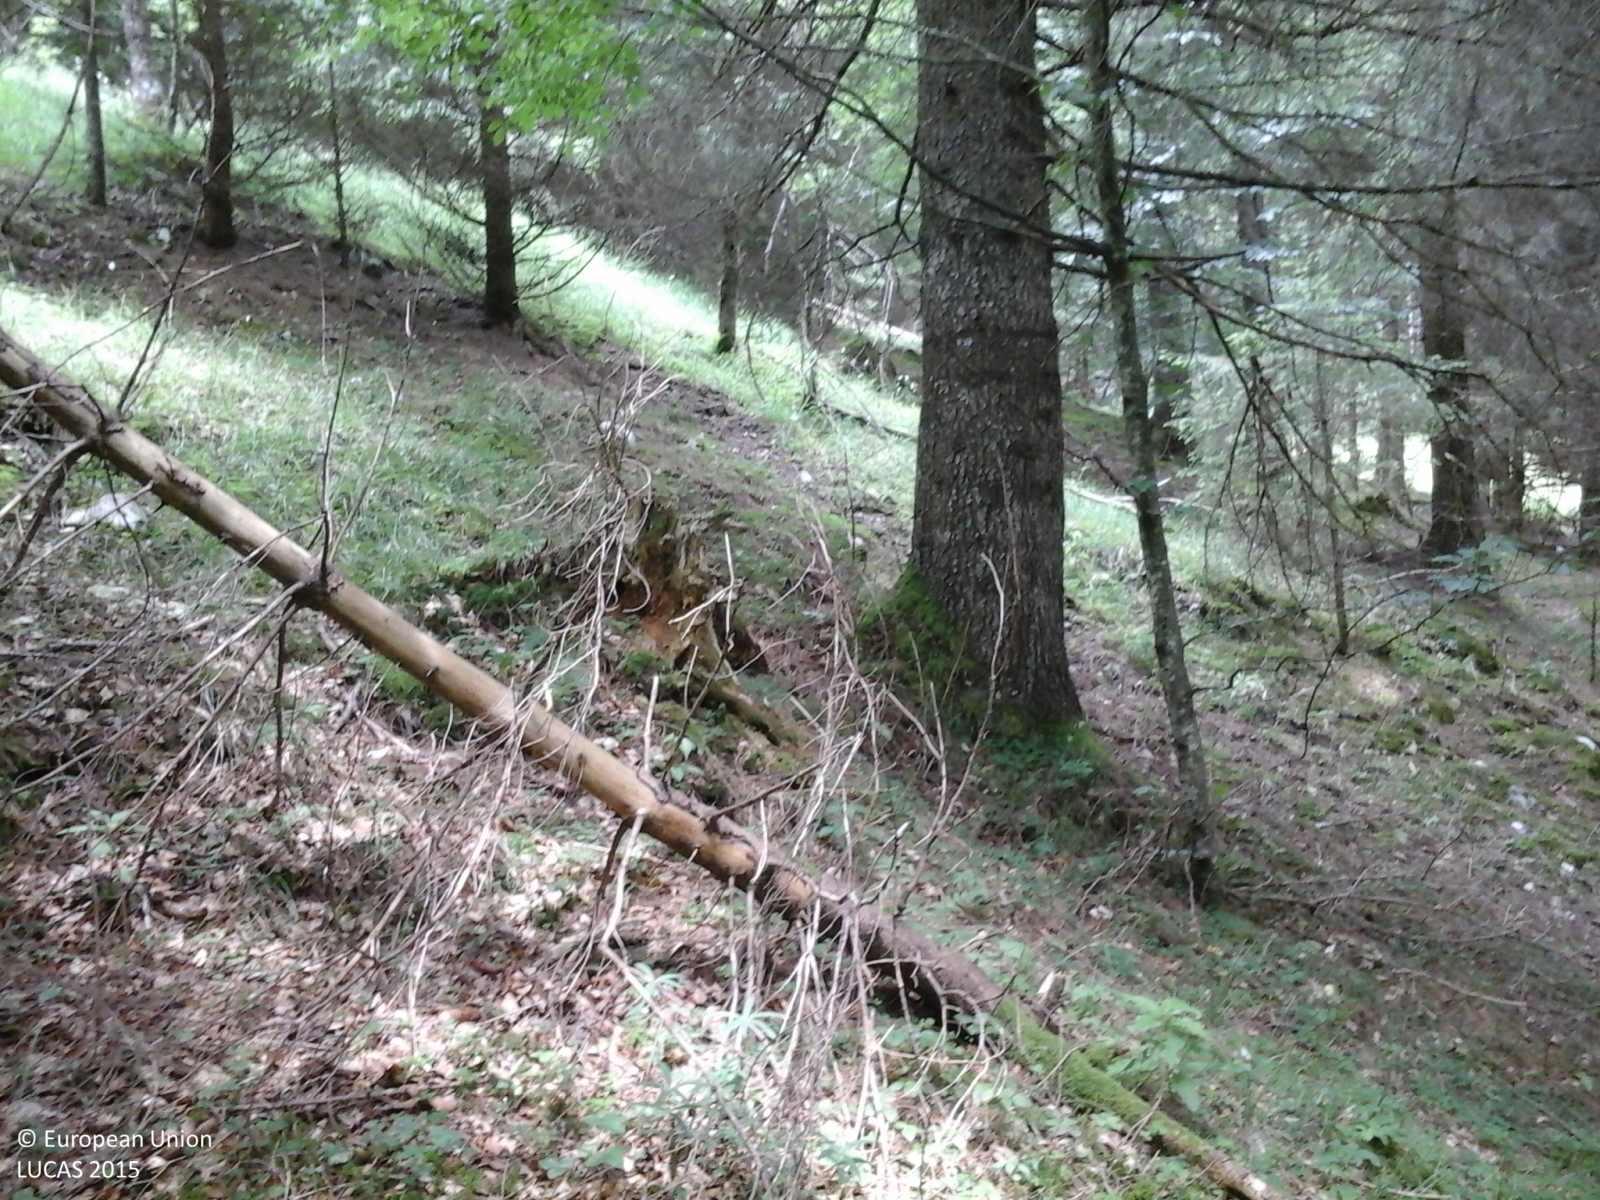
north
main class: Woodland
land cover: Spruce dominated mixed woodland
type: alpine coniferous forest
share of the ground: > 75 %
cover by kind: coniferous forest trees 75 %, broadleaved forest trees 25 %
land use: Semi-natural and natural areas not in use
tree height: > 5 m
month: June
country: IT
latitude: 46.0897
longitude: 12.4155
